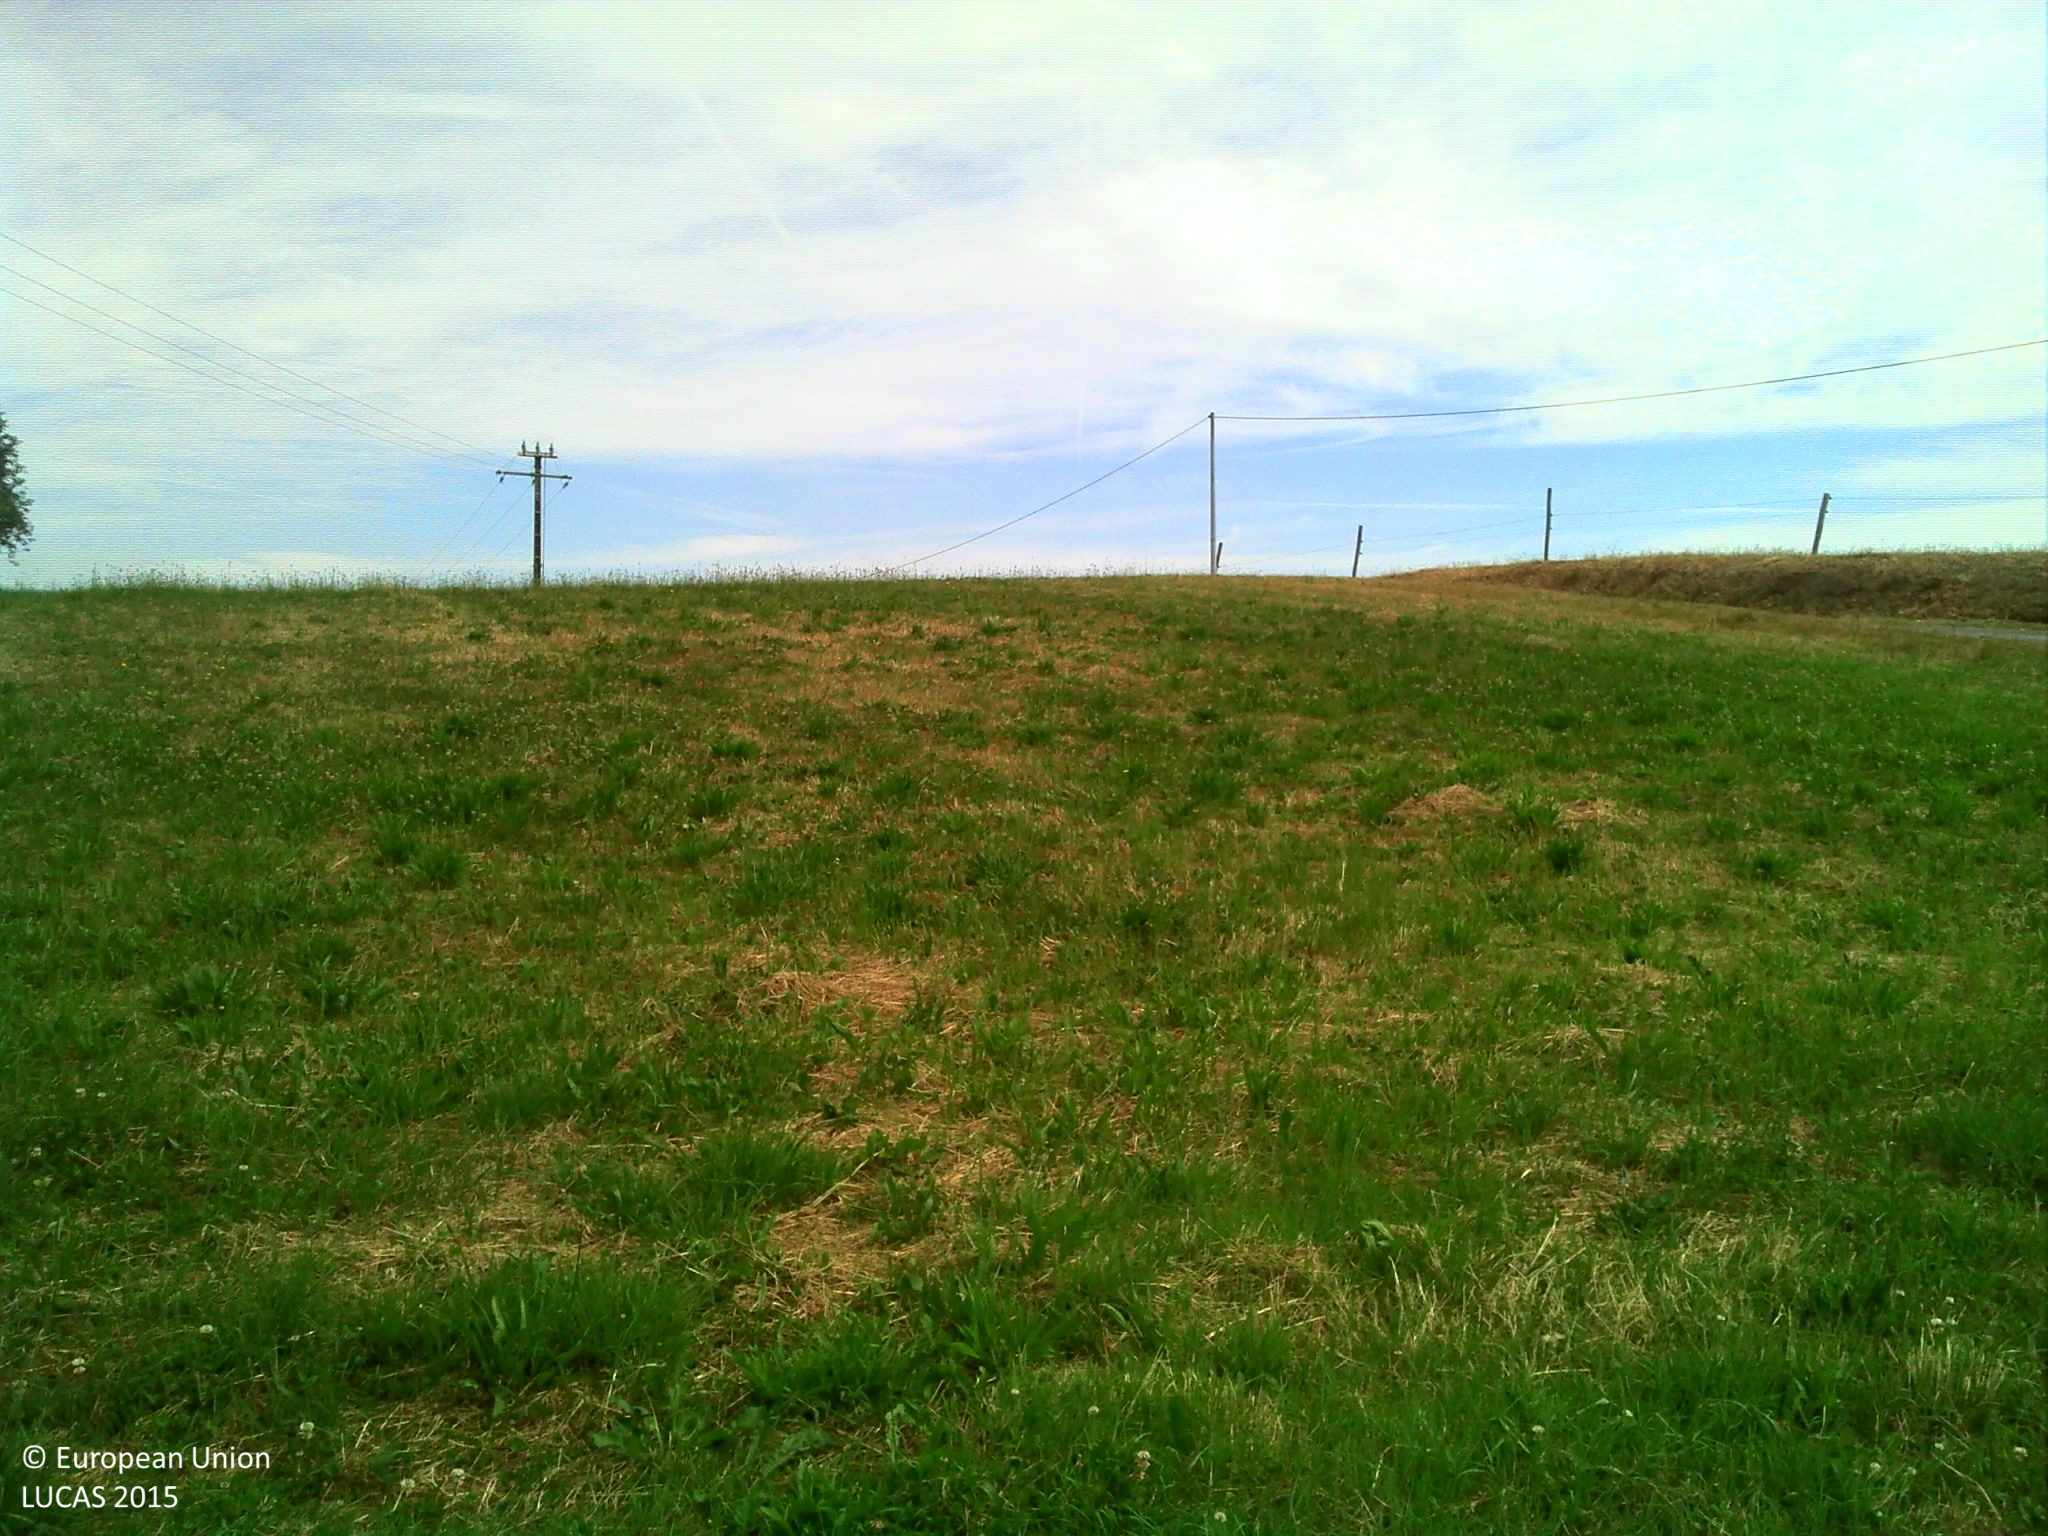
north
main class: Cropland
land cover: Apple fruit
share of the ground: > 75 %
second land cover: Grassland without tree/shrub cover
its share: > 75 %
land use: Agriculture (excluding fallow land and kitchen gardens)
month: June
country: FR
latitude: 47.9362
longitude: -1.5984
